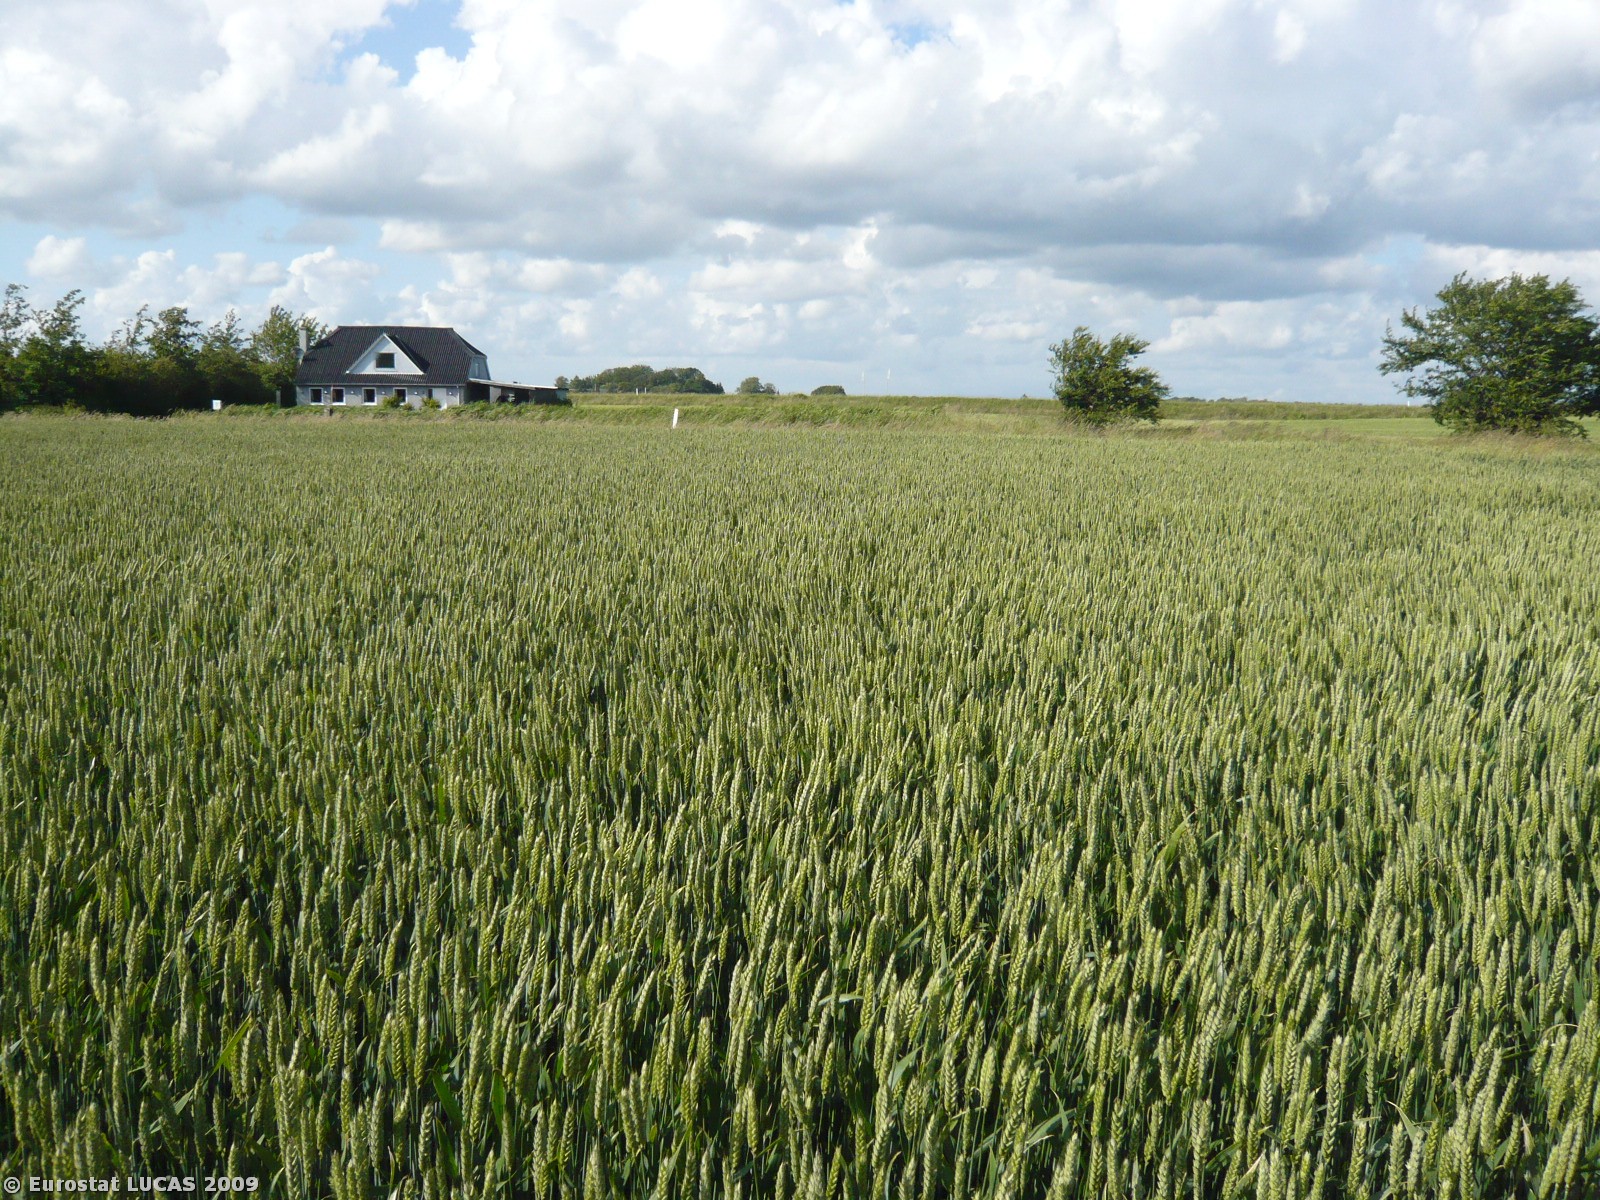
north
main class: Cropland
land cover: Common wheat
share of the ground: > 75 %
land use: Agriculture (excluding fallow land and kitchen gardens)
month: June
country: DK
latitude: 54.7044
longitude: 11.5354
